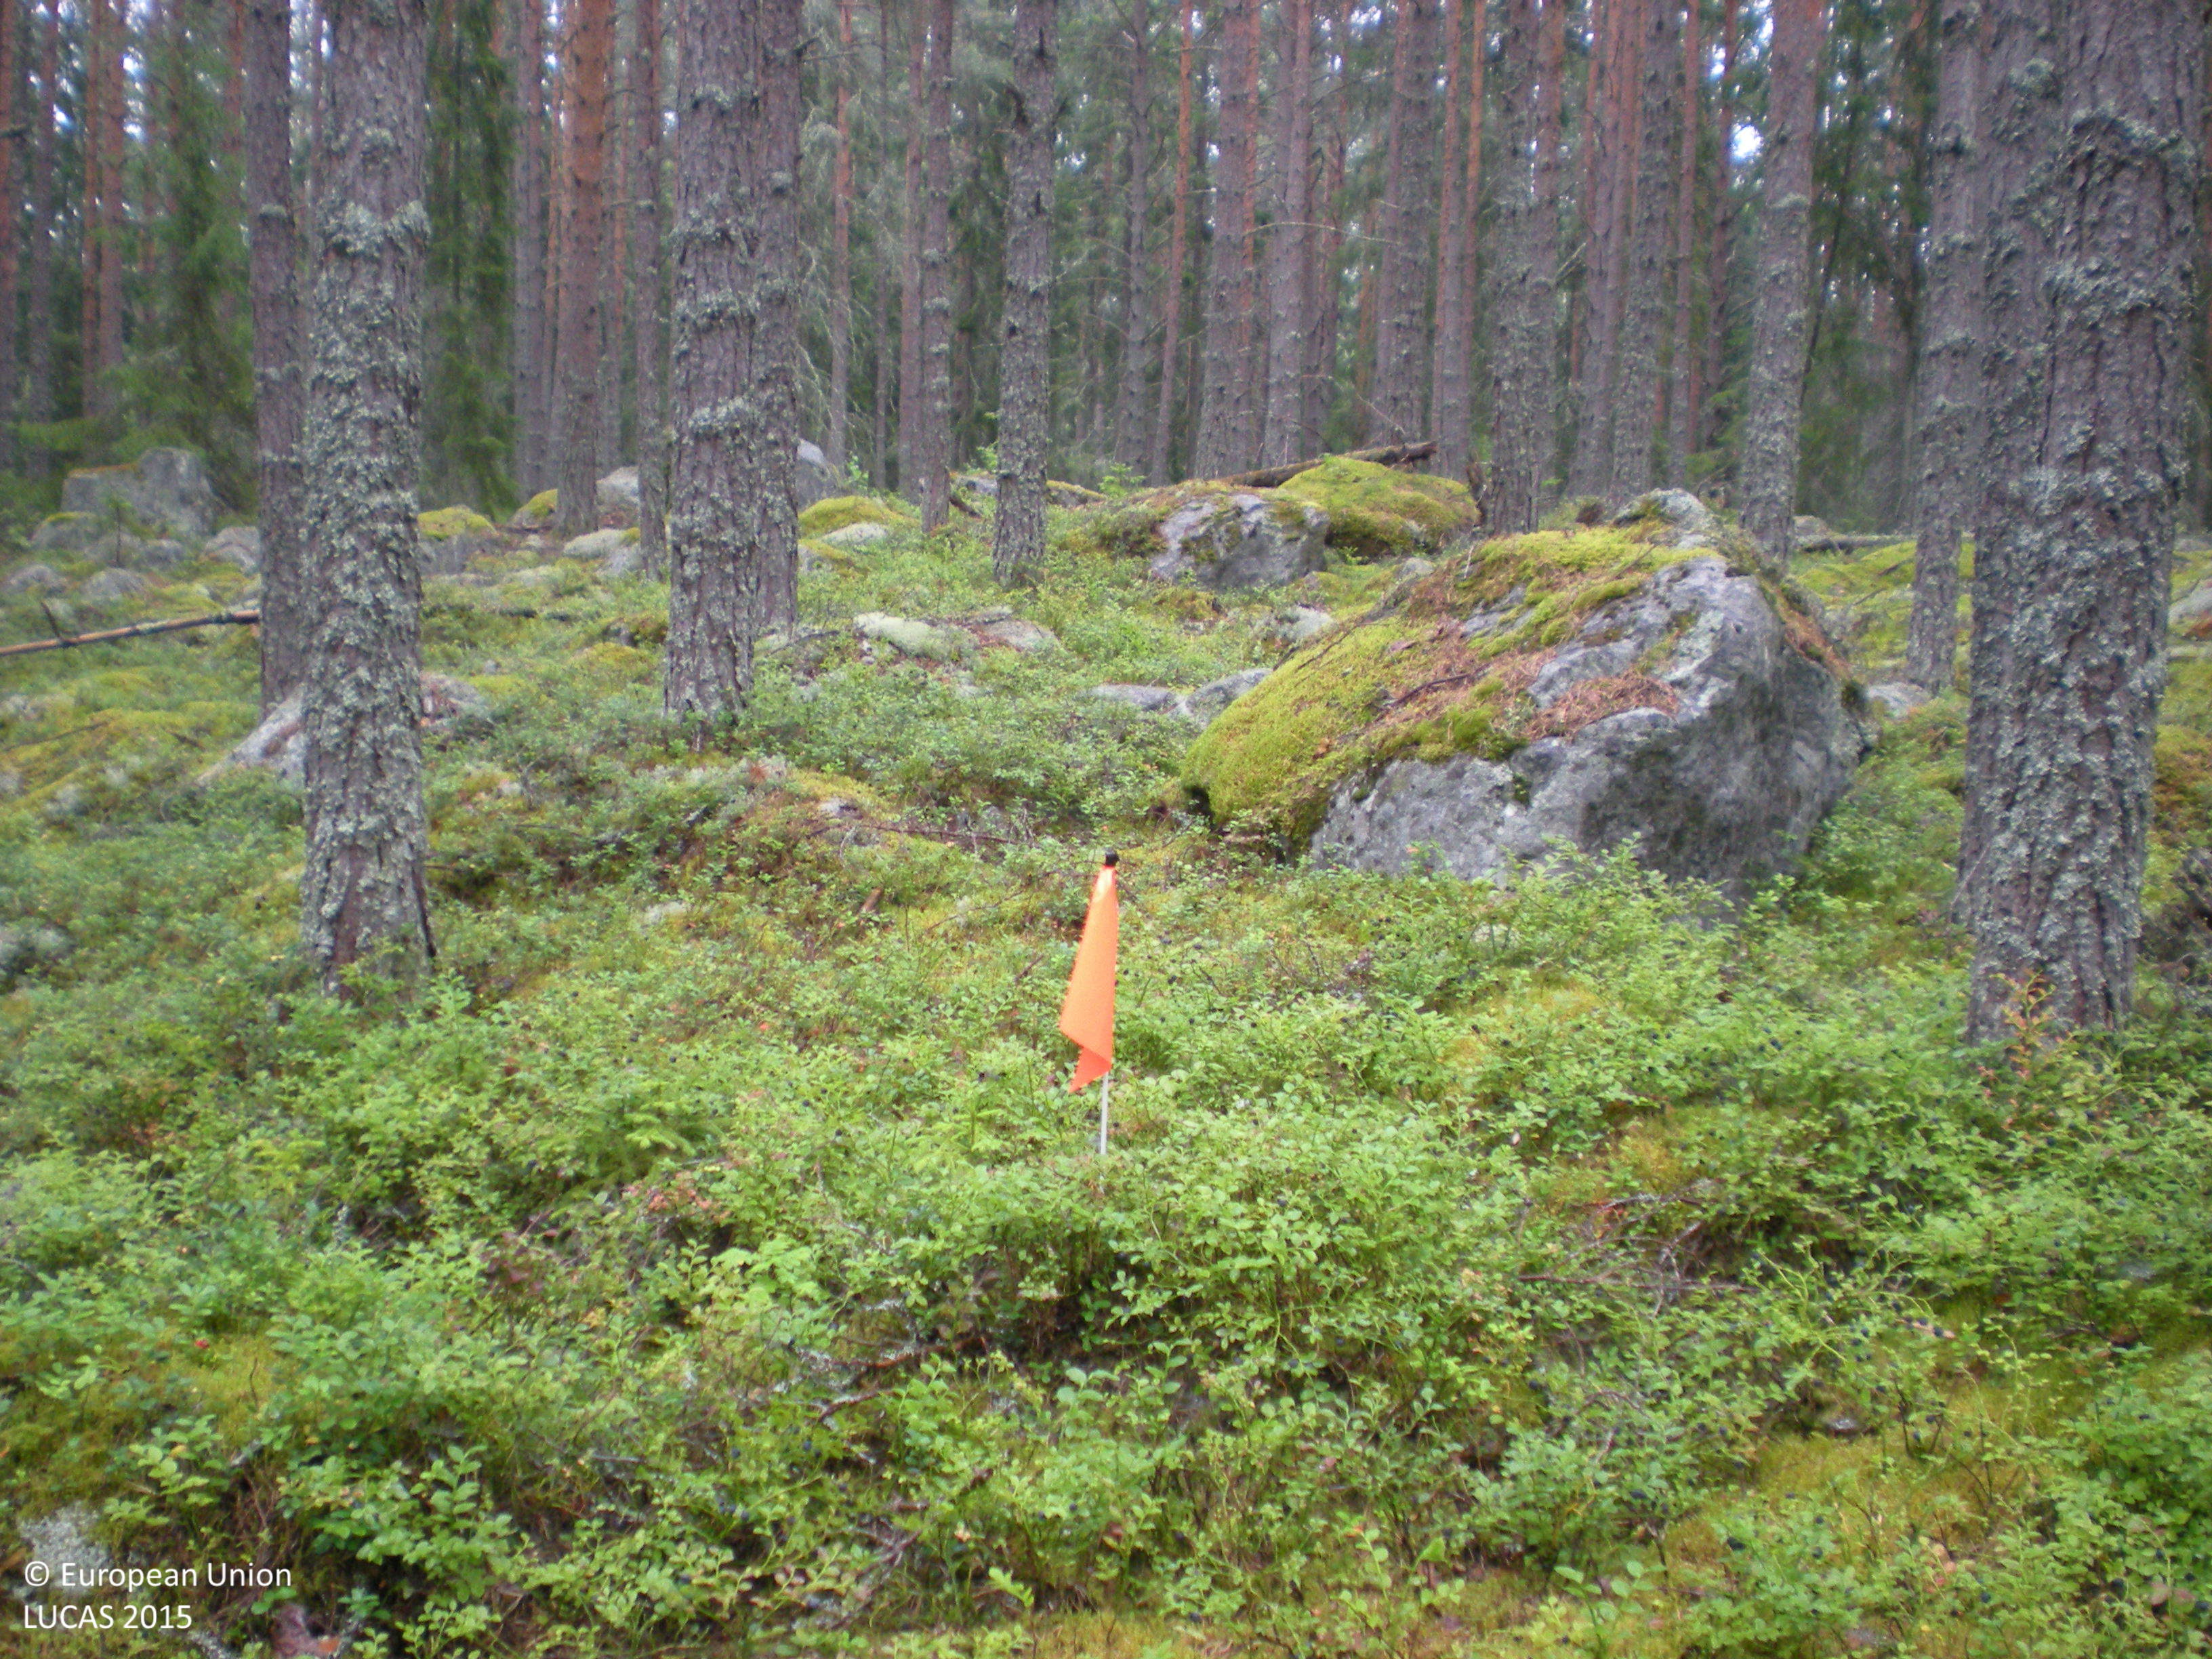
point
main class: Woodland
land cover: Pine dominated coniferous woodland
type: boreal forest
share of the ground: 50 - 75 %
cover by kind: coniferous forest trees 65 %, shrubs 20 %, lichens and mosses 10 %, consolidated bare surface 5 %
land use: Forestry
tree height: > 5 m
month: August
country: SE
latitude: 60.7706
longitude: 17.2773
